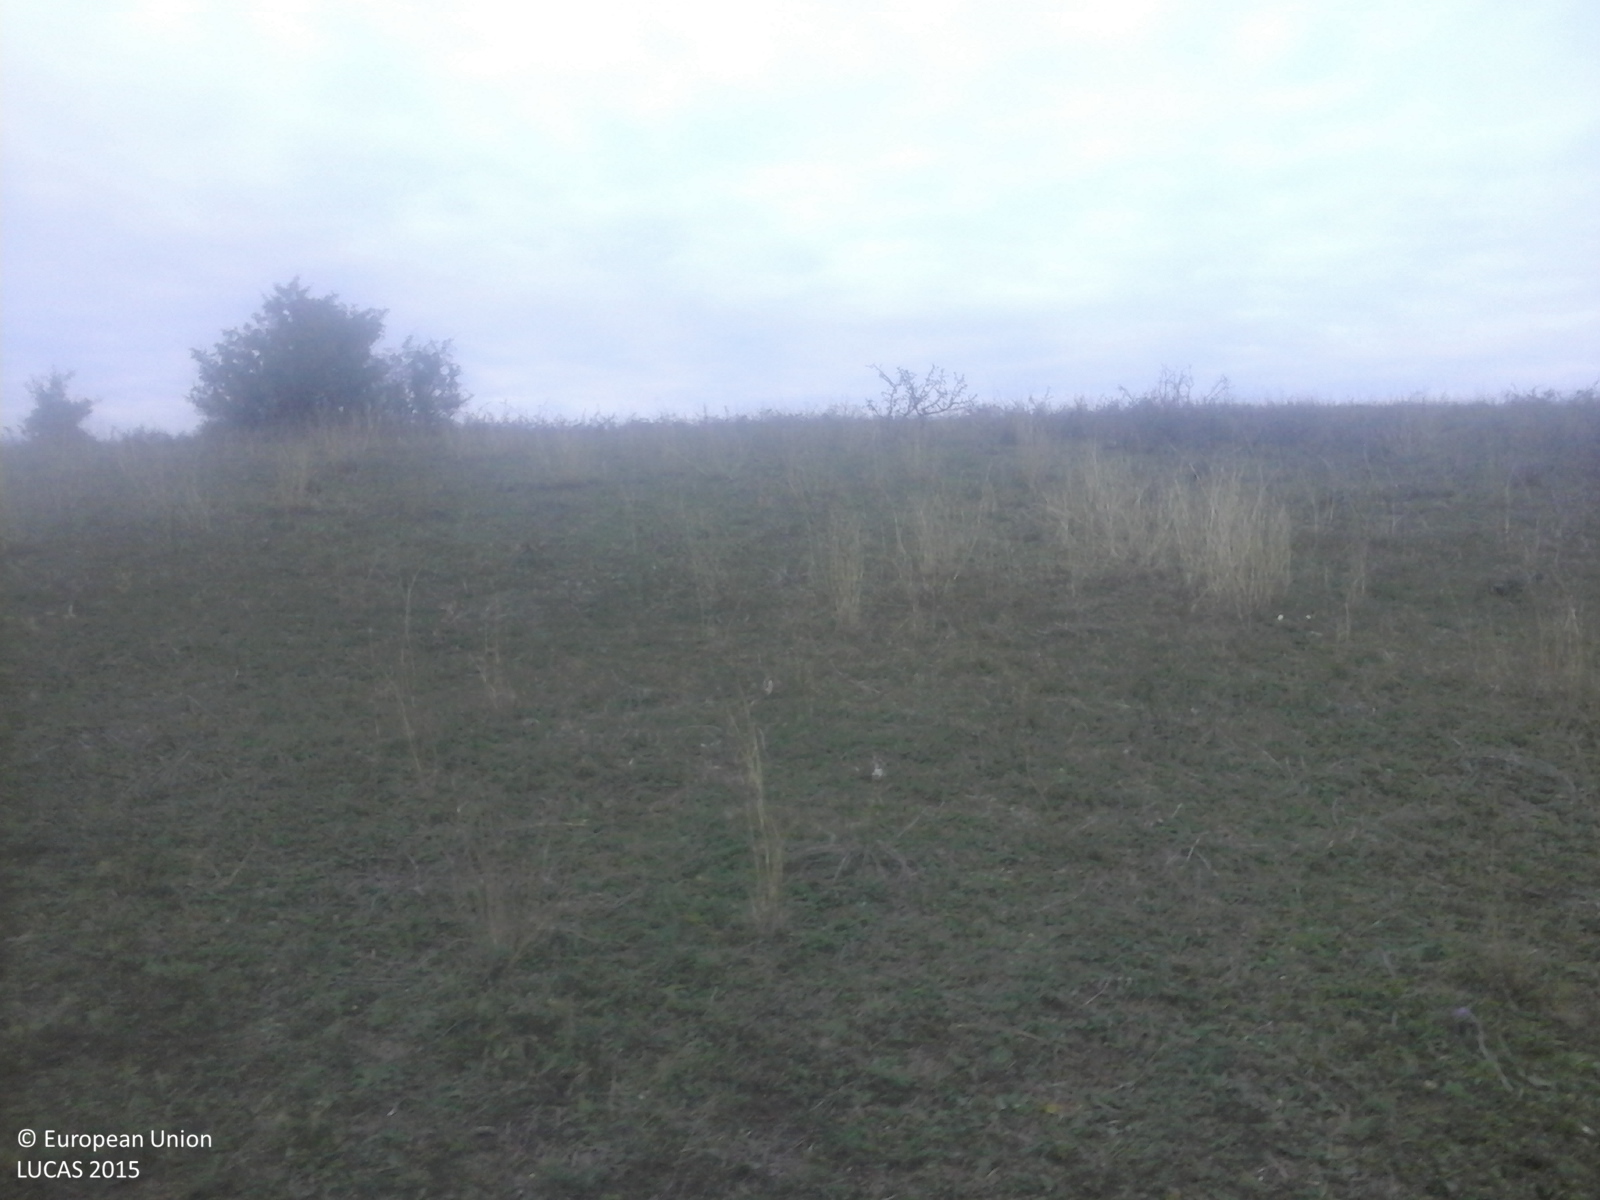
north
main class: Grassland
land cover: Grassland with sparse tree/shrub cover
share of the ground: > 75 %
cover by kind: herbaceous plants 85 %, shrubs 10 %, broadleaved forest trees 5 %
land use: Fallow land
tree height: < 5 m
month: September
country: RO
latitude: 45.9083
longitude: 23.7982
